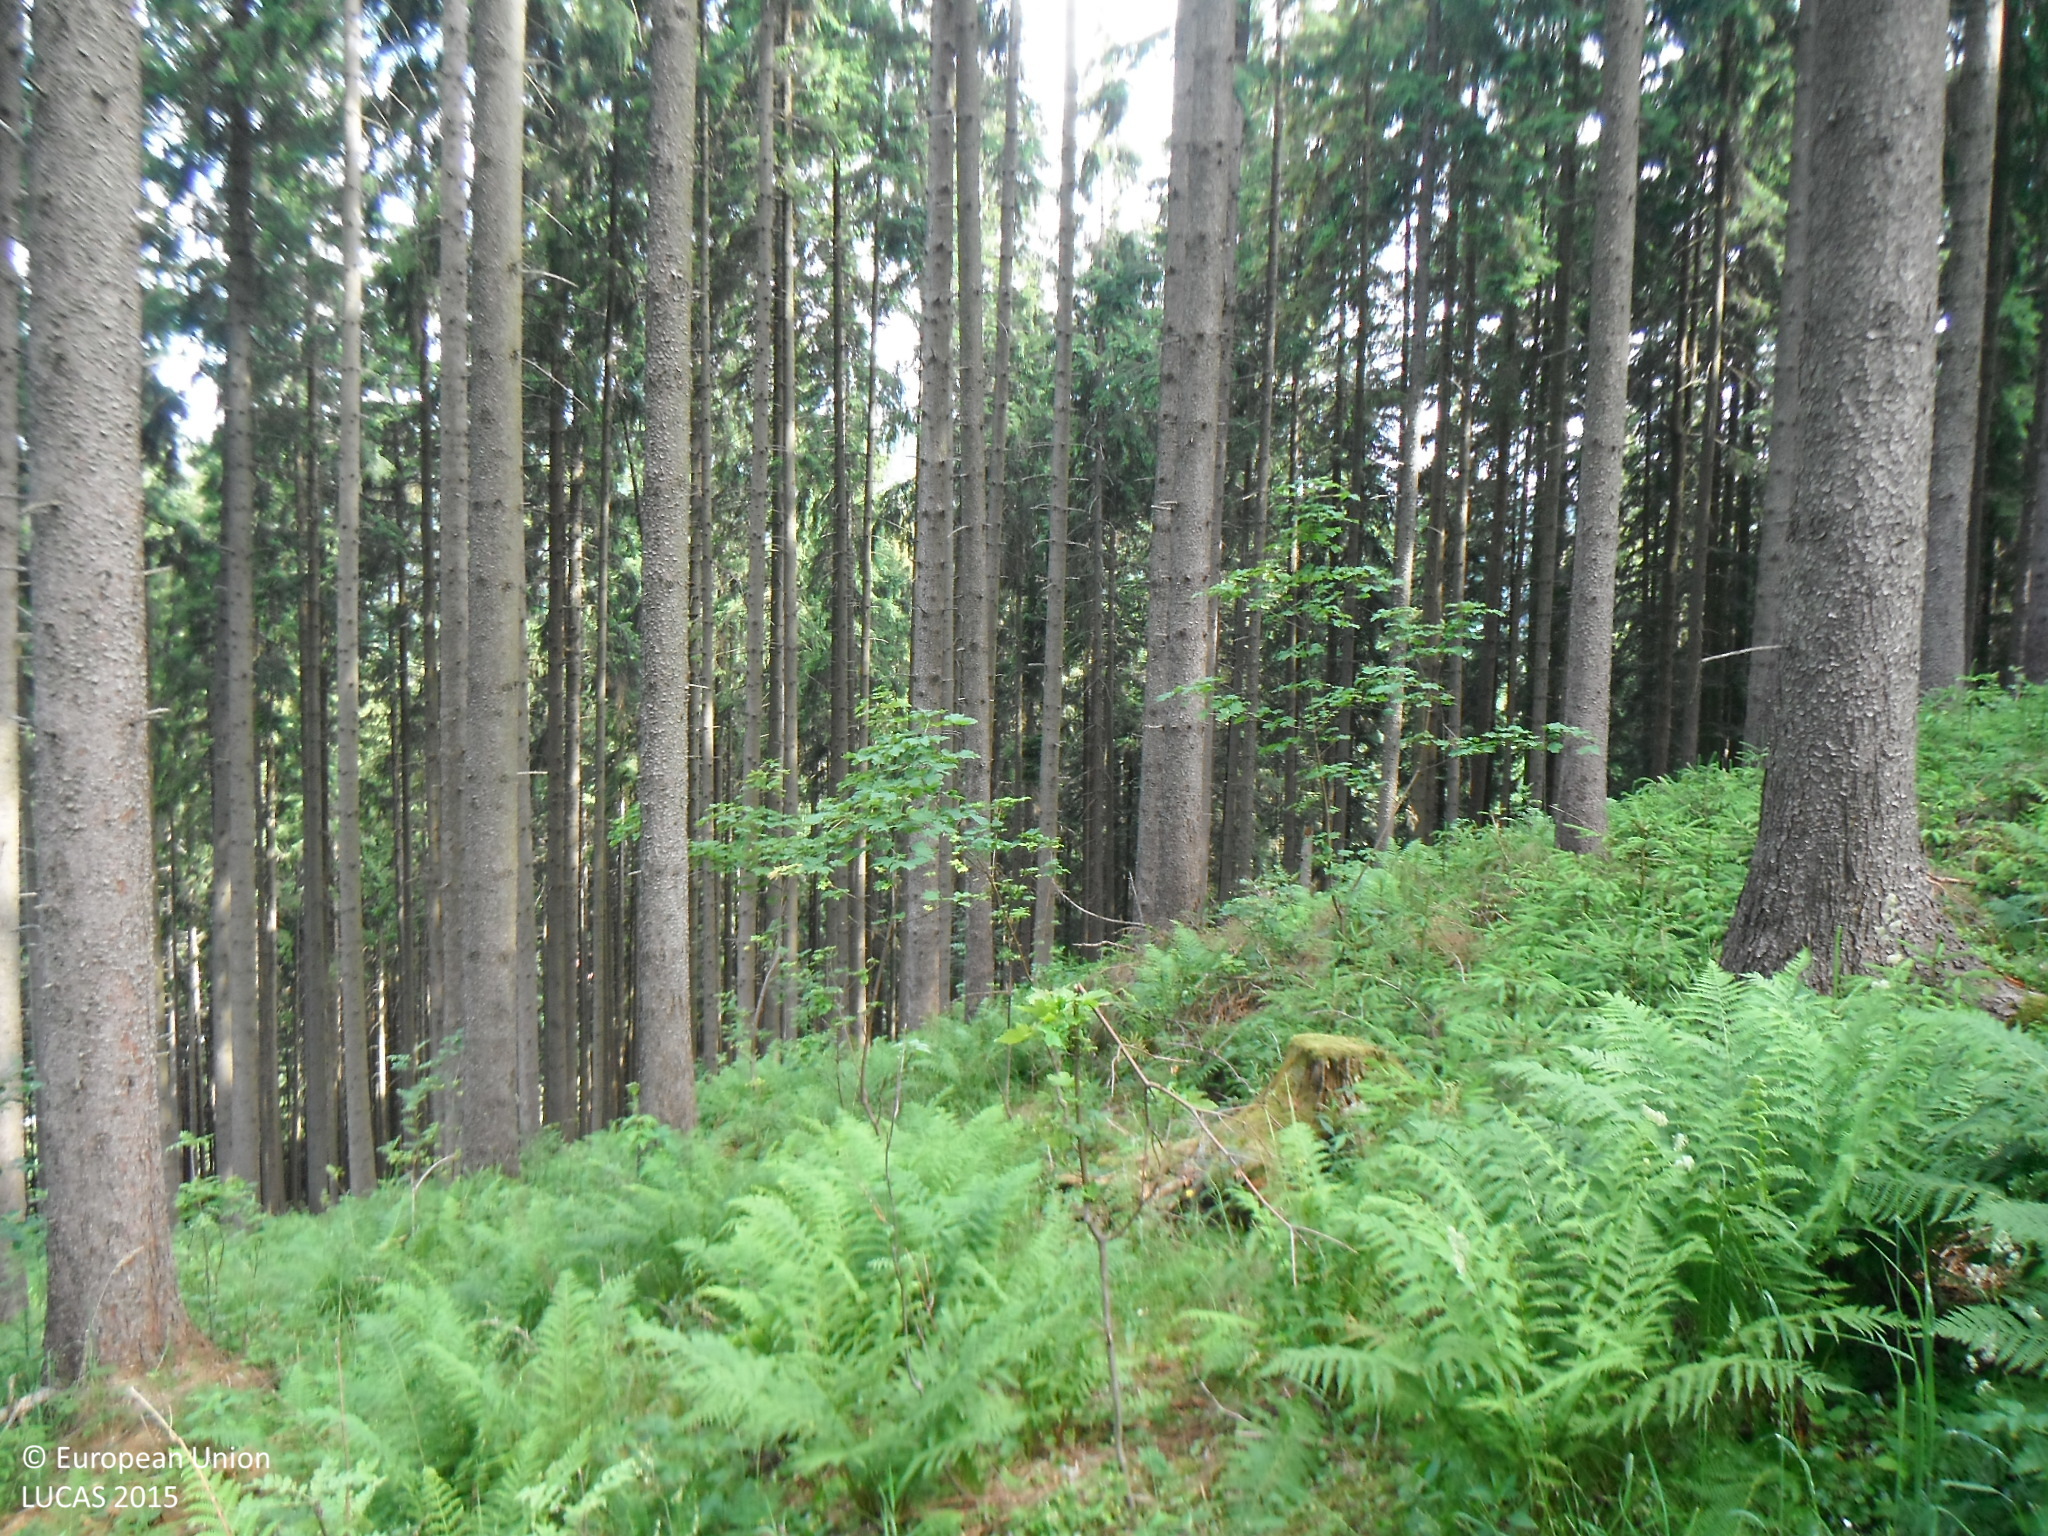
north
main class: Woodland
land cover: Spruce dominated coniferous woodland
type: alpine coniferous forest
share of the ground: > 75 %
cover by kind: coniferous forest trees 75 %, herbaceous plants 15 %, shrubs 10 %
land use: Forestry
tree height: > 5 m
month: July
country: SK
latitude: 49.3632
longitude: 18.4587
